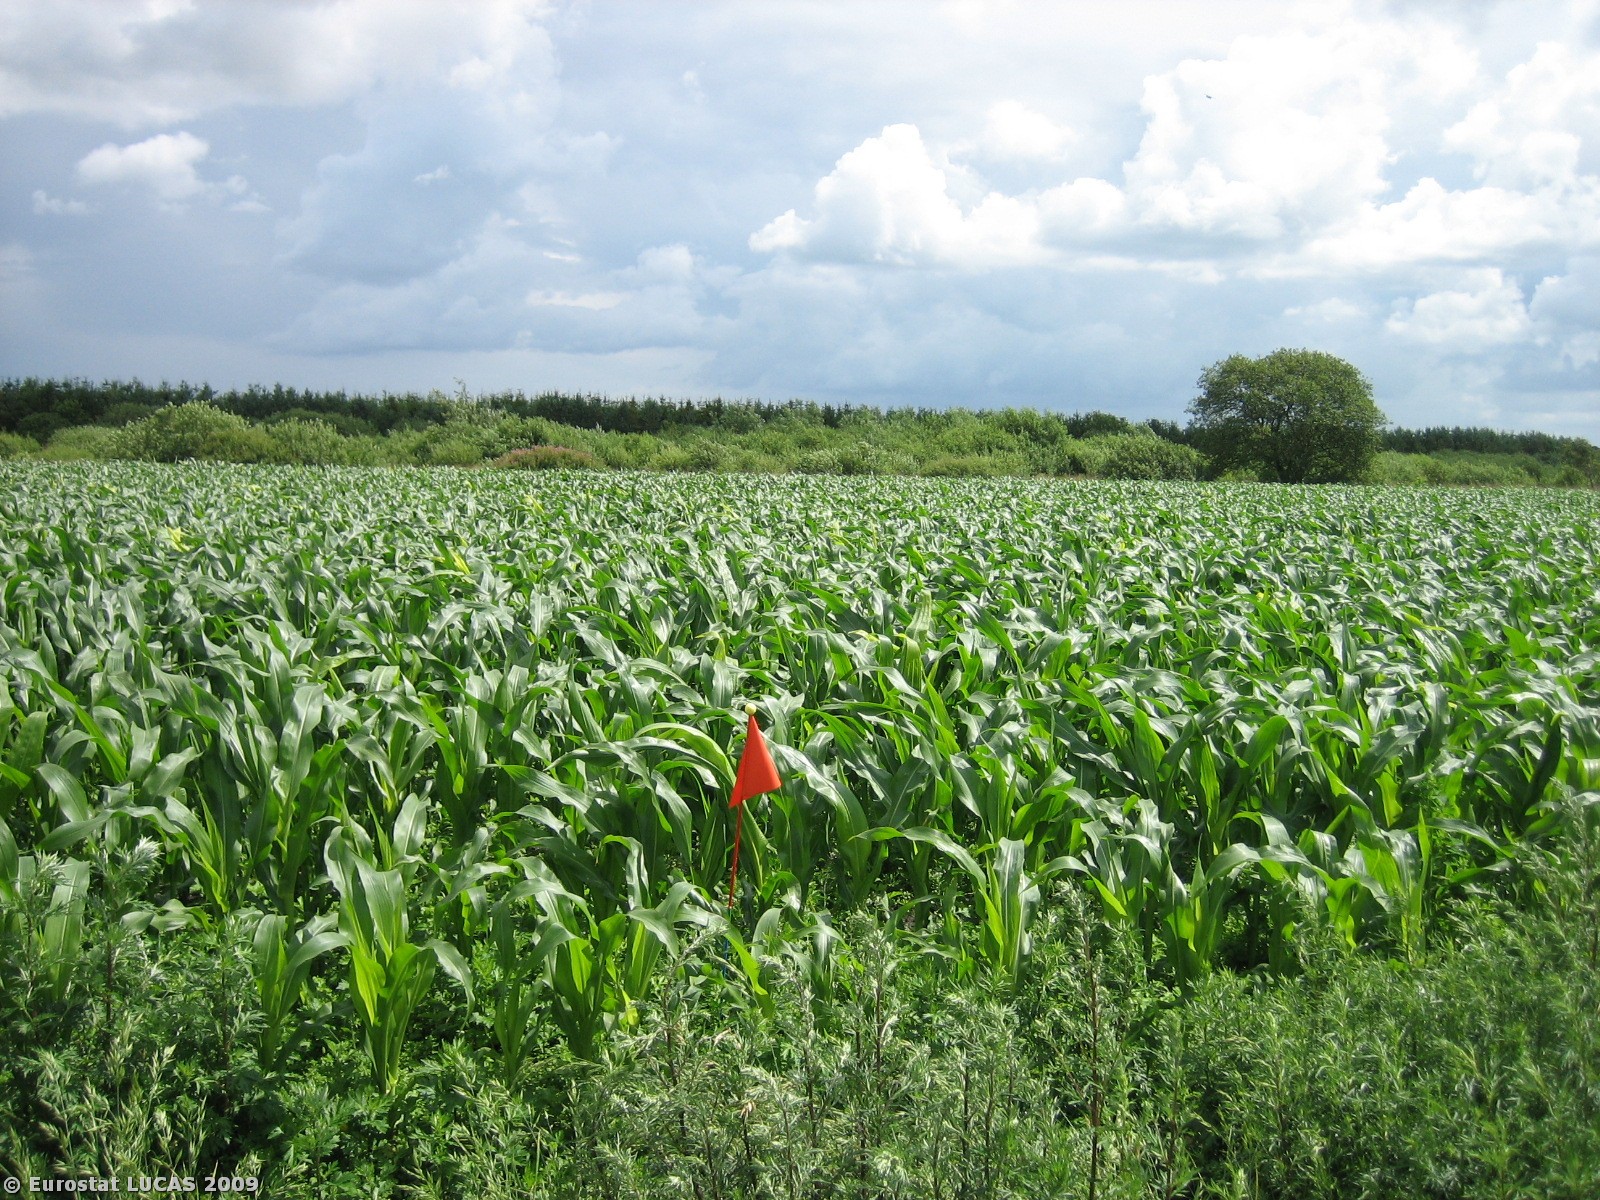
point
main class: Cropland
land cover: Maize
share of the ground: 25 - 50 %
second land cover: Spontaneously vegetated surfaces
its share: > 75 %
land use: Agriculture (excluding fallow land and kitchen gardens)
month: July
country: DK
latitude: 55.6426
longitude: 8.7778
